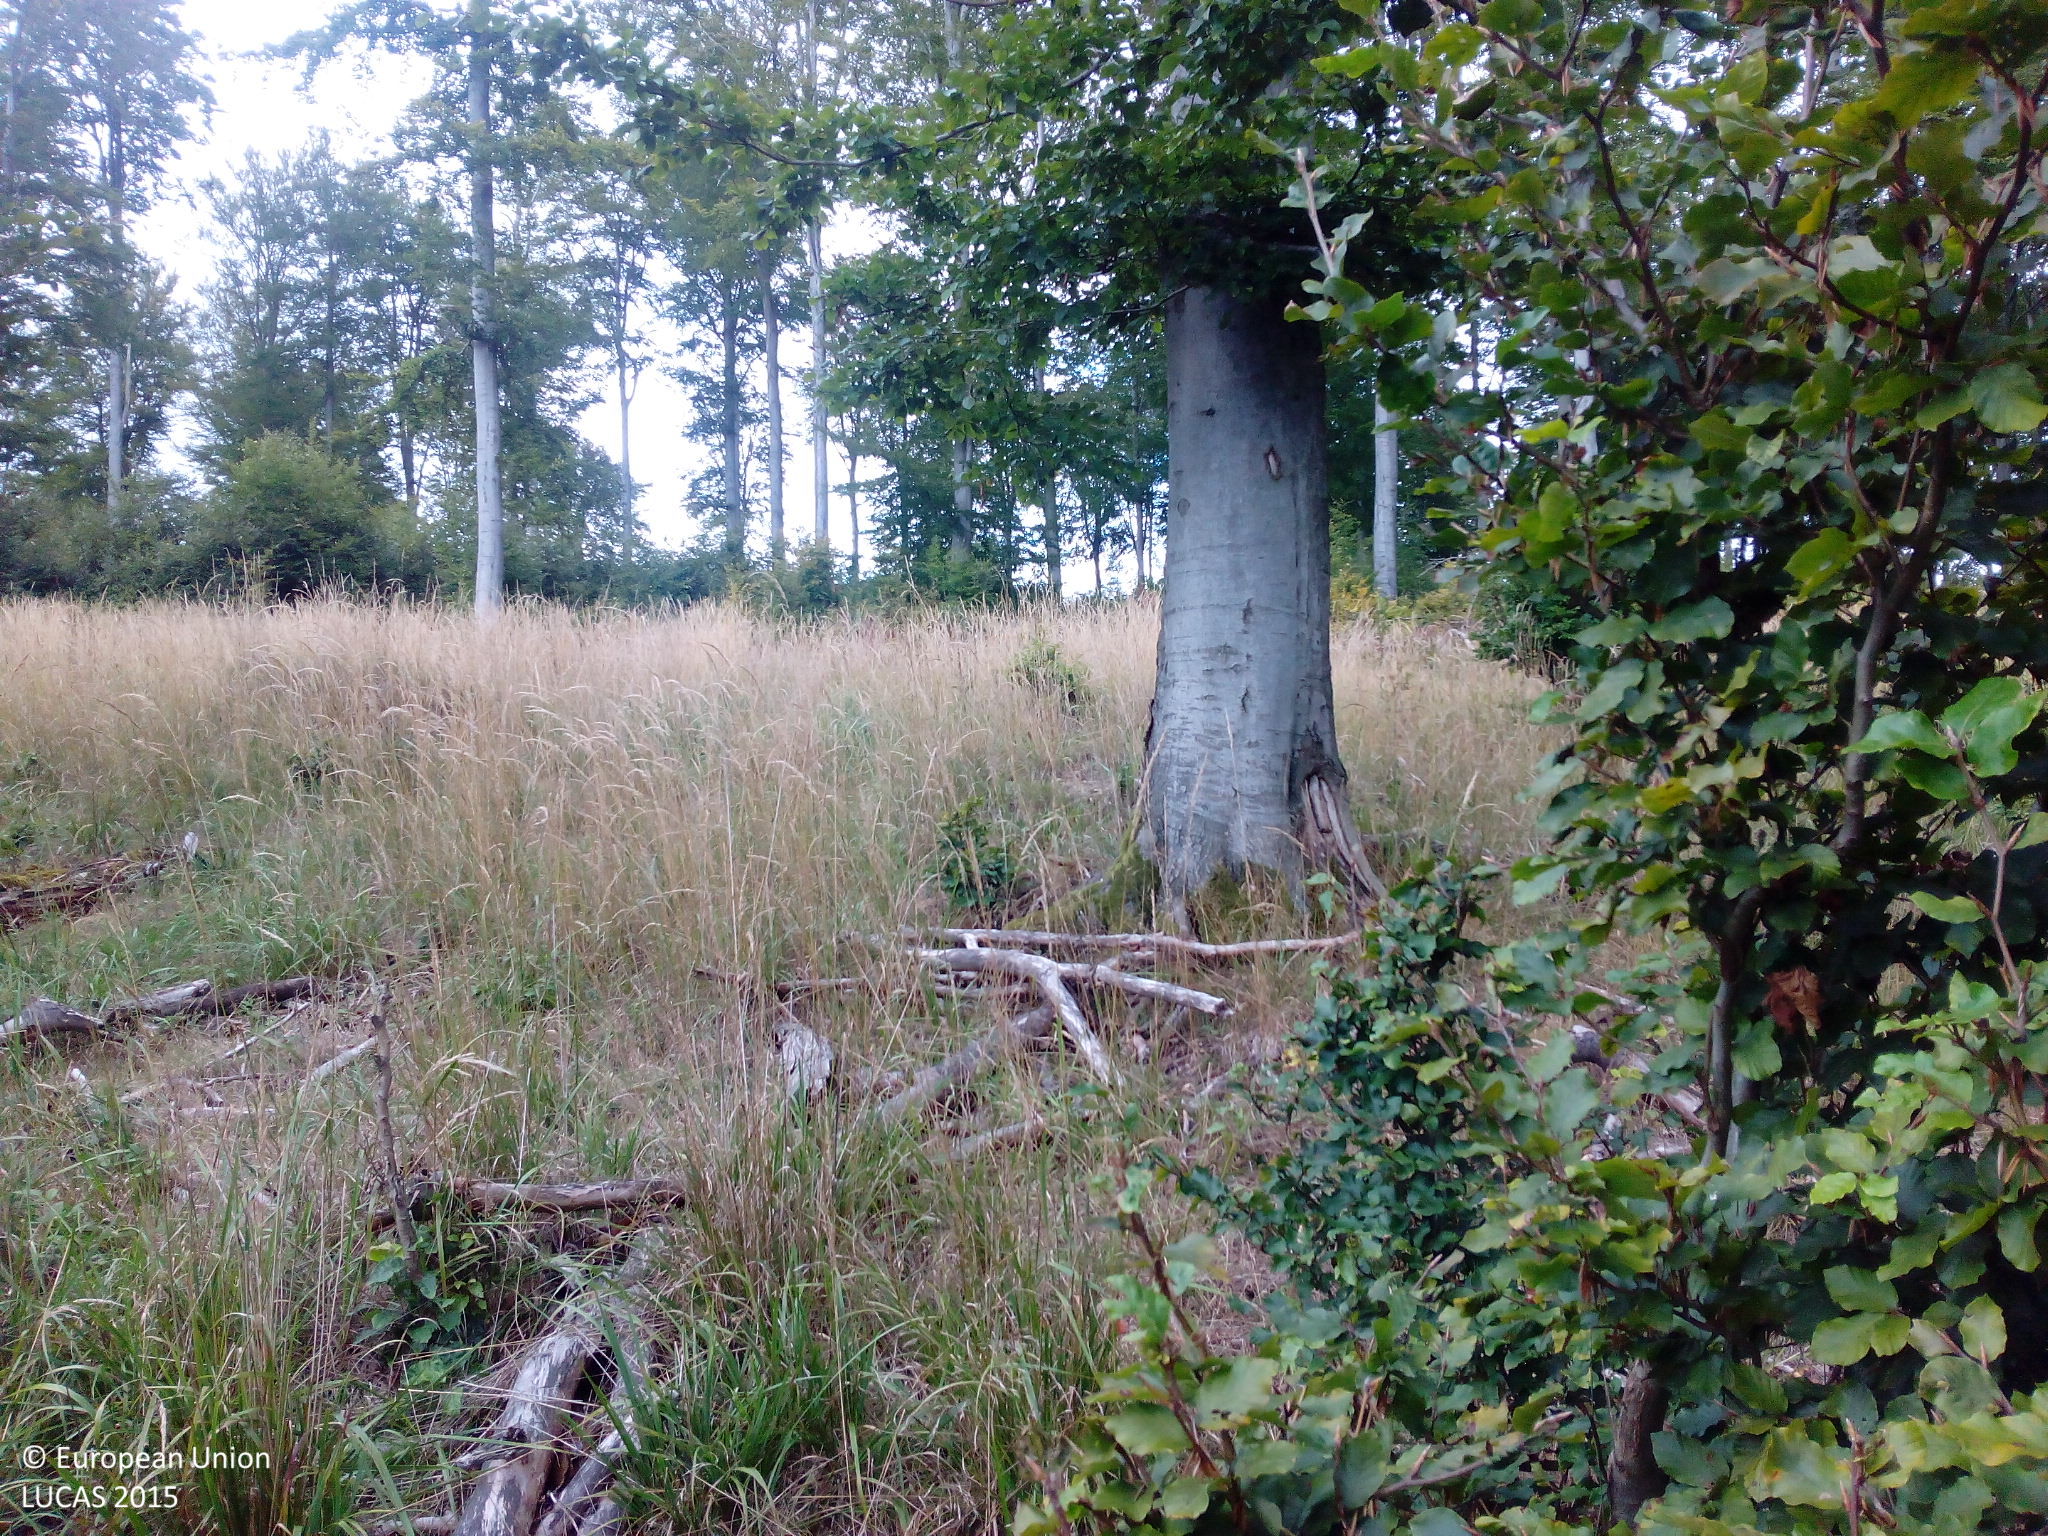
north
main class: Woodland
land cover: Broadleaved woodland
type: beech forest
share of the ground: 50 - 75 %
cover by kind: broadleaved forest trees 70 %, herbaceous plants 30 %
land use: Forestry
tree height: > 5 m
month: September
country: DE
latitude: 51.6005
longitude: 10.9670
